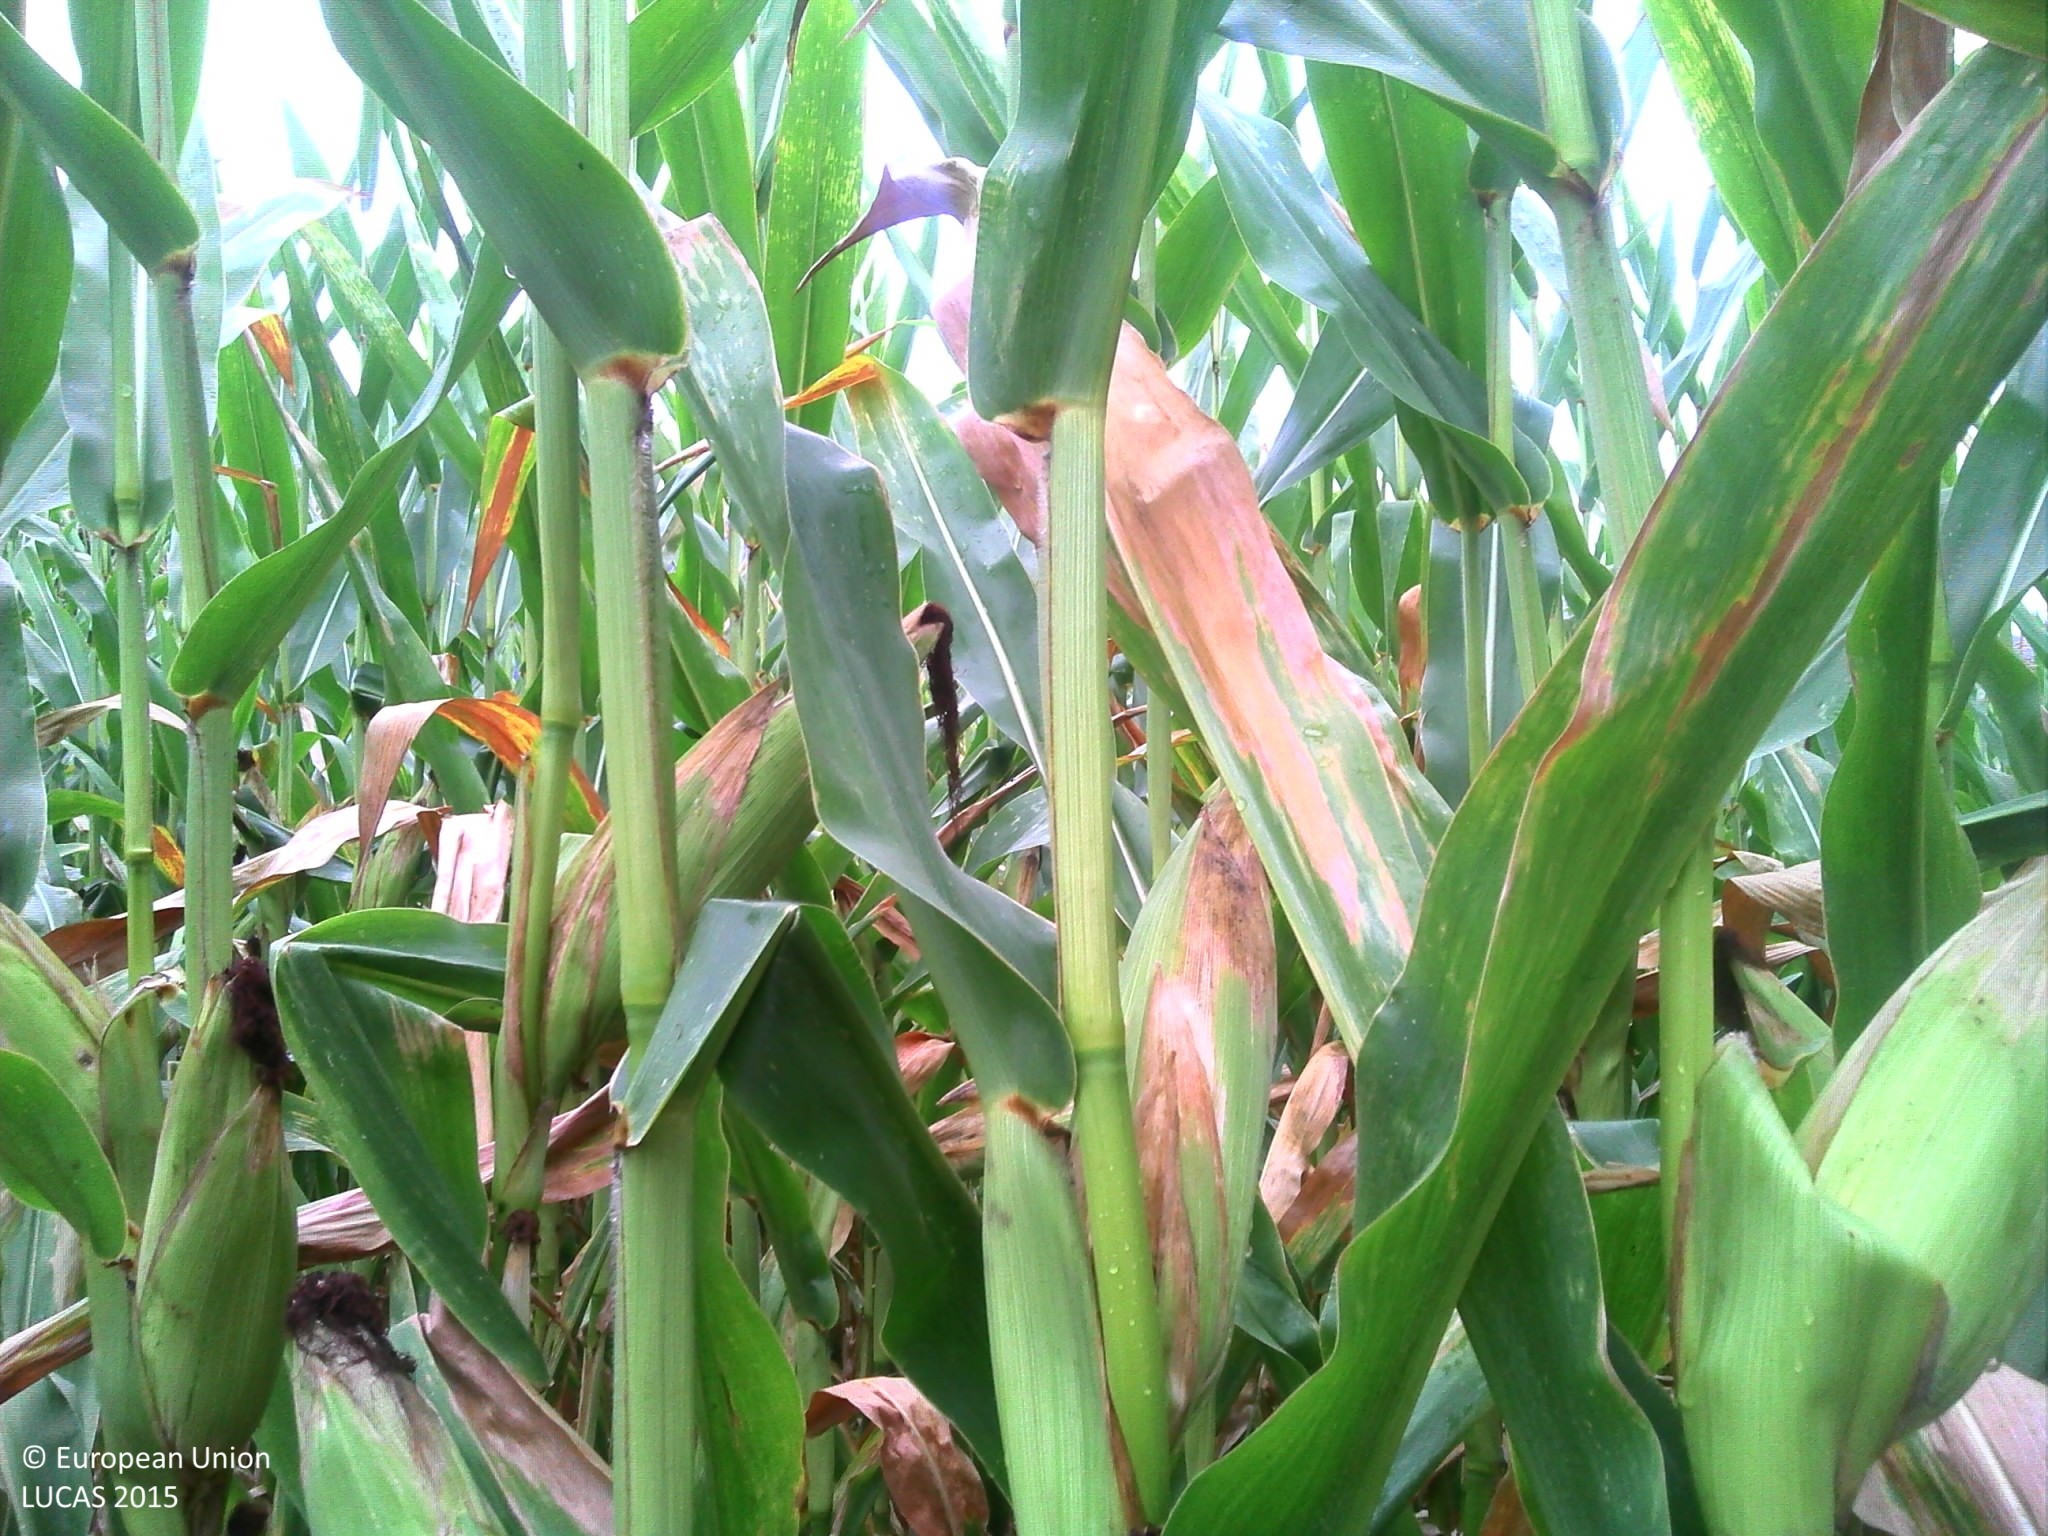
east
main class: Cropland
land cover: Maize
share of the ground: > 75 %
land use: Agriculture (excluding fallow land and kitchen gardens)
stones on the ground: < 10 %
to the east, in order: Maize; Grass margins; Ditches and canals; Broadleaved woodland; Tracks; Grass margins; Maize
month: August
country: FR
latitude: 45.2517
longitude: 5.6348
